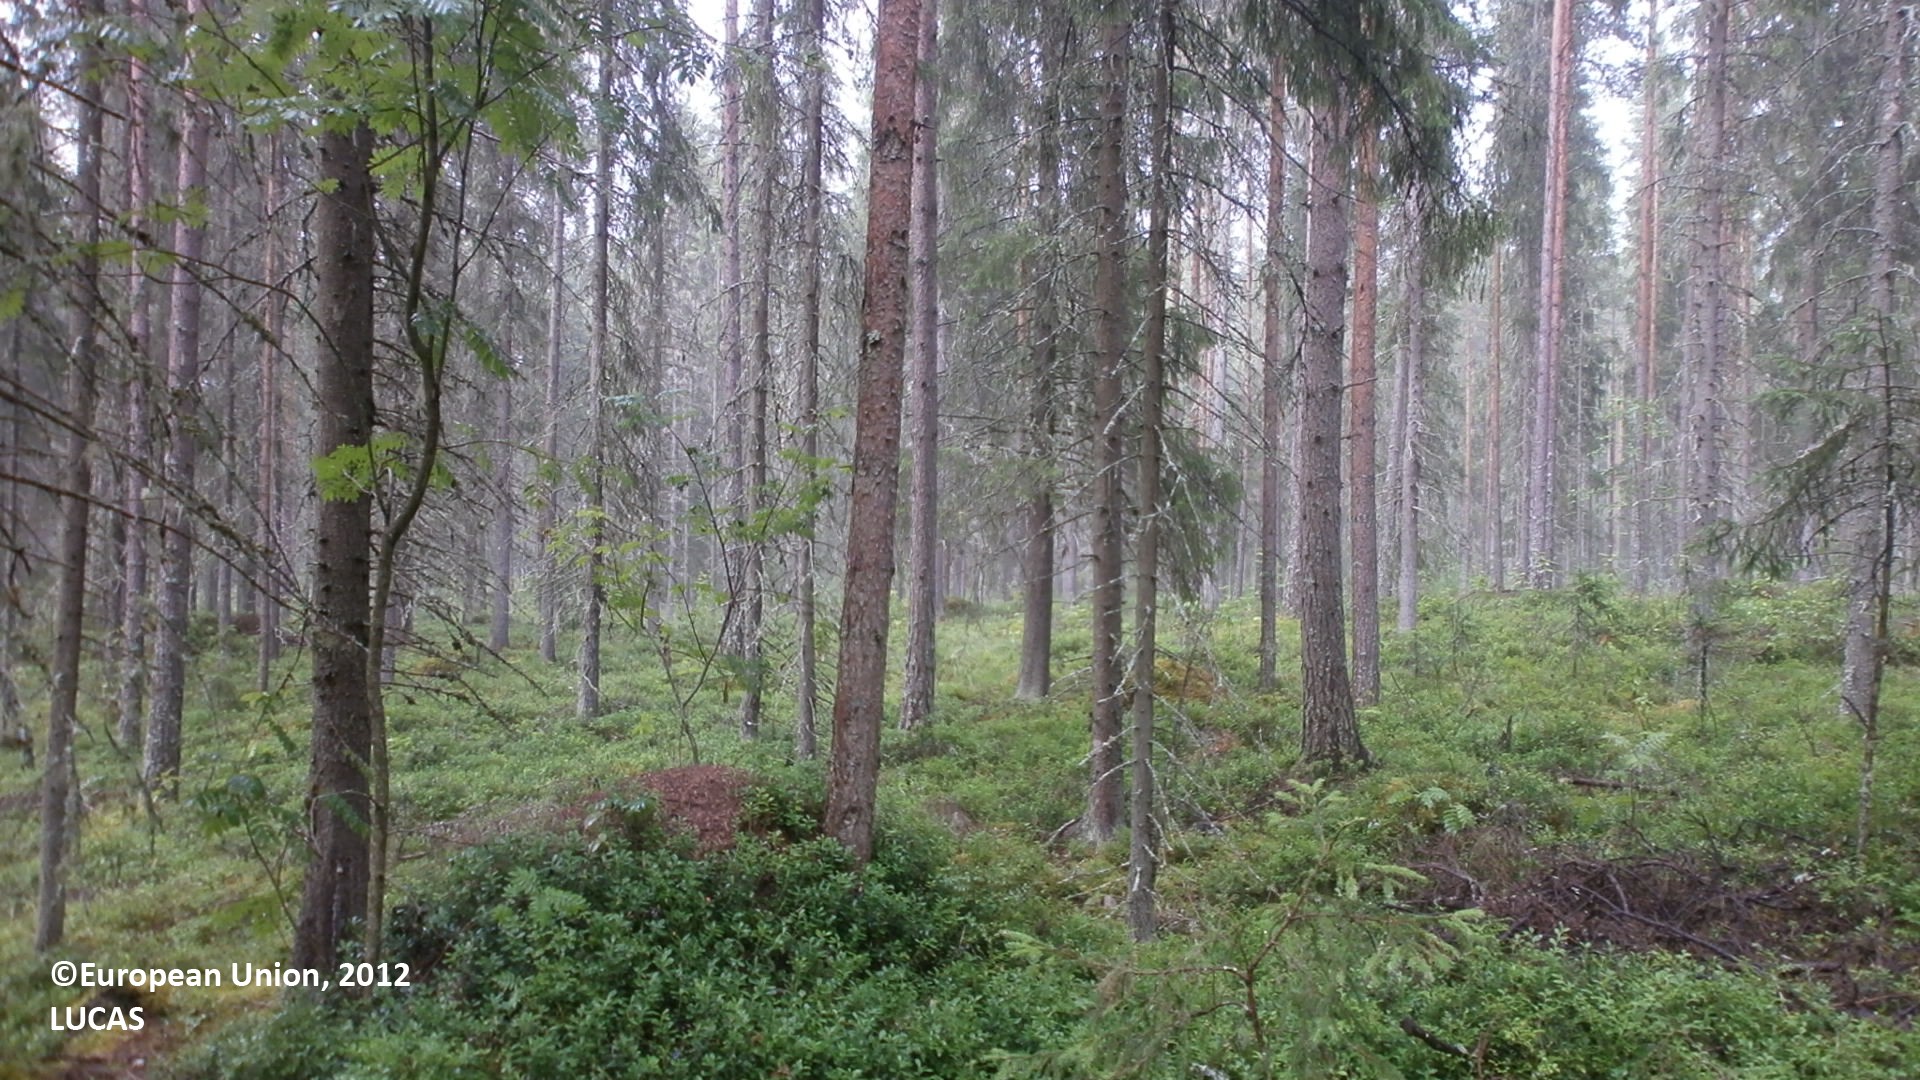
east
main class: Woodland
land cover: Spruce dominated coniferous woodland
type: boreal forest
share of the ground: 50 - 75 %
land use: Forestry
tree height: > 5 m
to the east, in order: Spruce dominated coniferous woodland; Tracks; Spruce dominated coniferous woodland; Tracks; Spruce dominated coniferous woodland; Spontaneously vegetated surfaces; Spruce dominated mixed woodland; Inland running water; Spruce dominated coniferous woodland; Ditches and canals; Grass margins; Paved roads, cycling and walking lanes; Grass margins; Single bushes/trees; Shrubland without tree cover
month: July
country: FI
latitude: 64.0874
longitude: 23.7819
